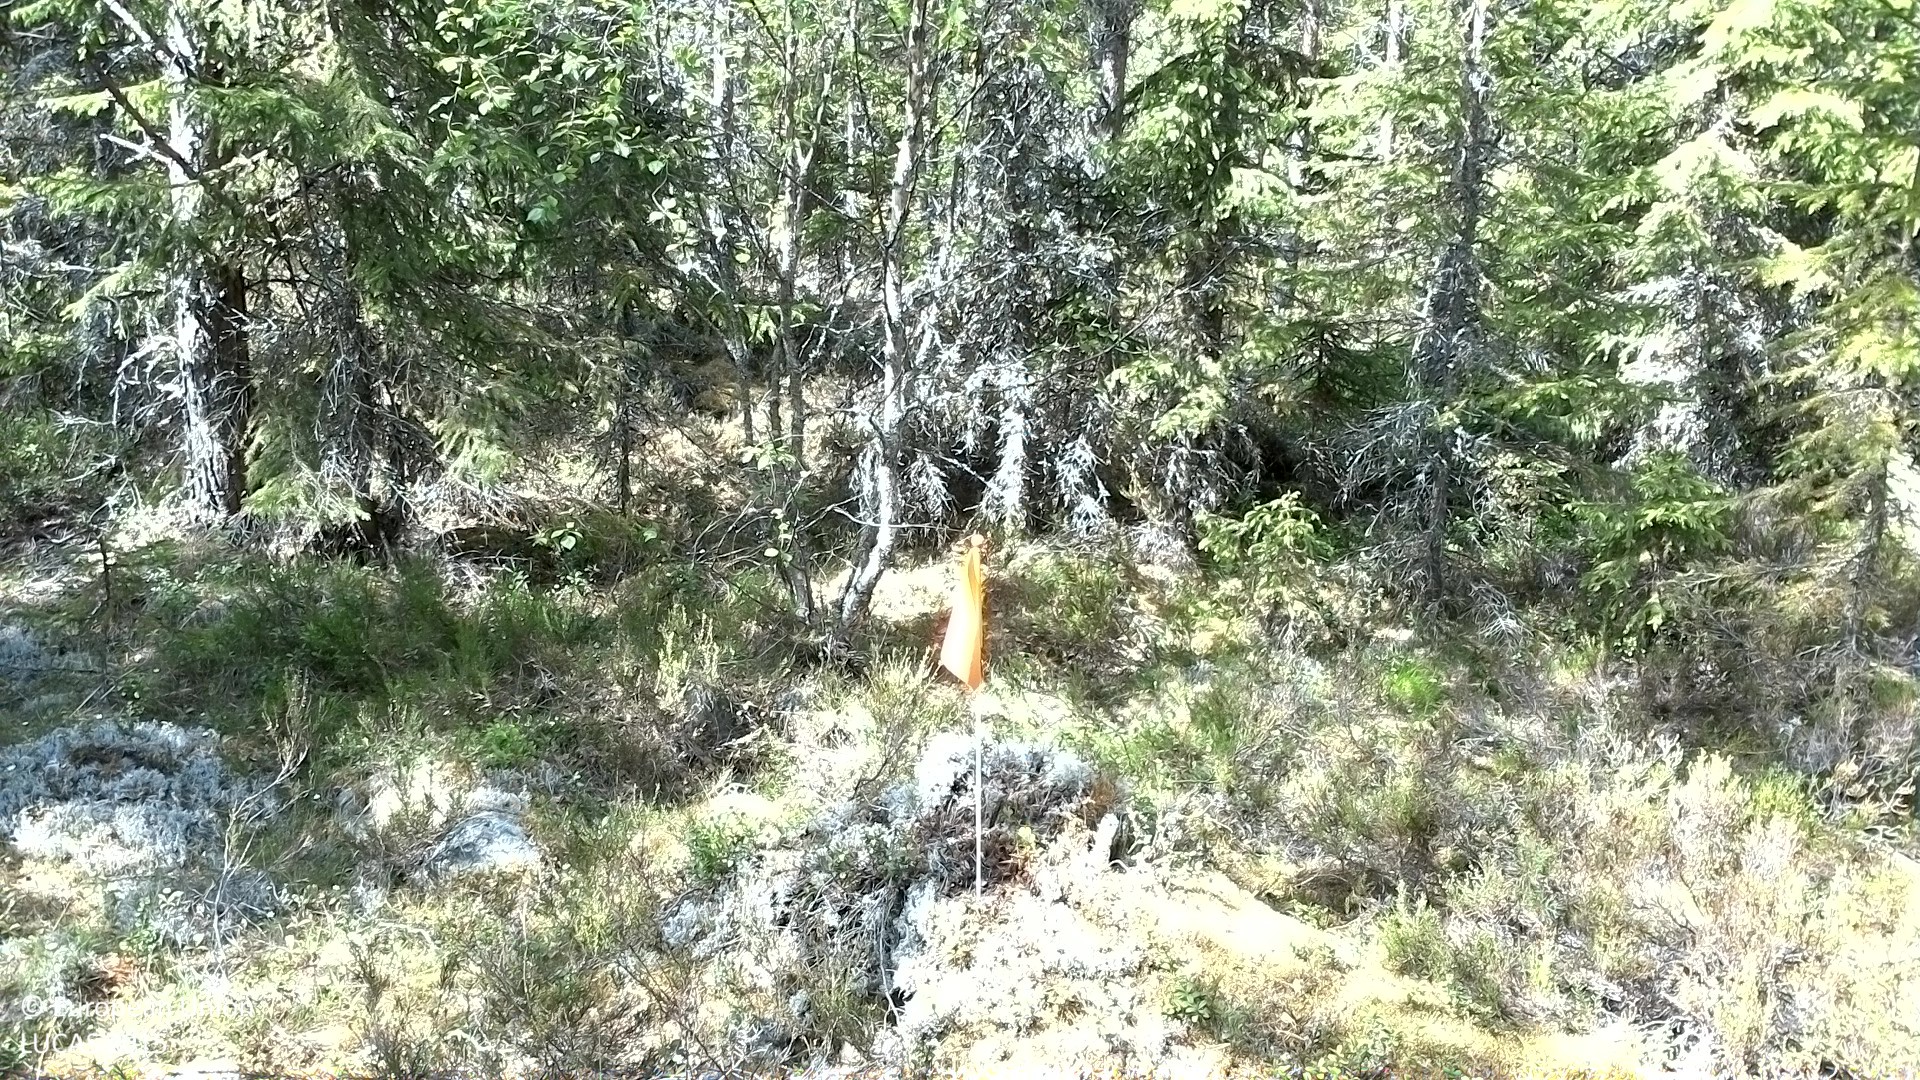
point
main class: Woodland
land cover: Other coniferous woodland
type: boreal forest
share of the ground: 50 - 75 %
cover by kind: coniferous forest trees 45 %, shrubs 30 %, lichens and mosses 15 %, broadleaved forest trees 10 %
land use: Forestry
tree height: > 5 m
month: June
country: SE
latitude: 62.2041
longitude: 17.5749
